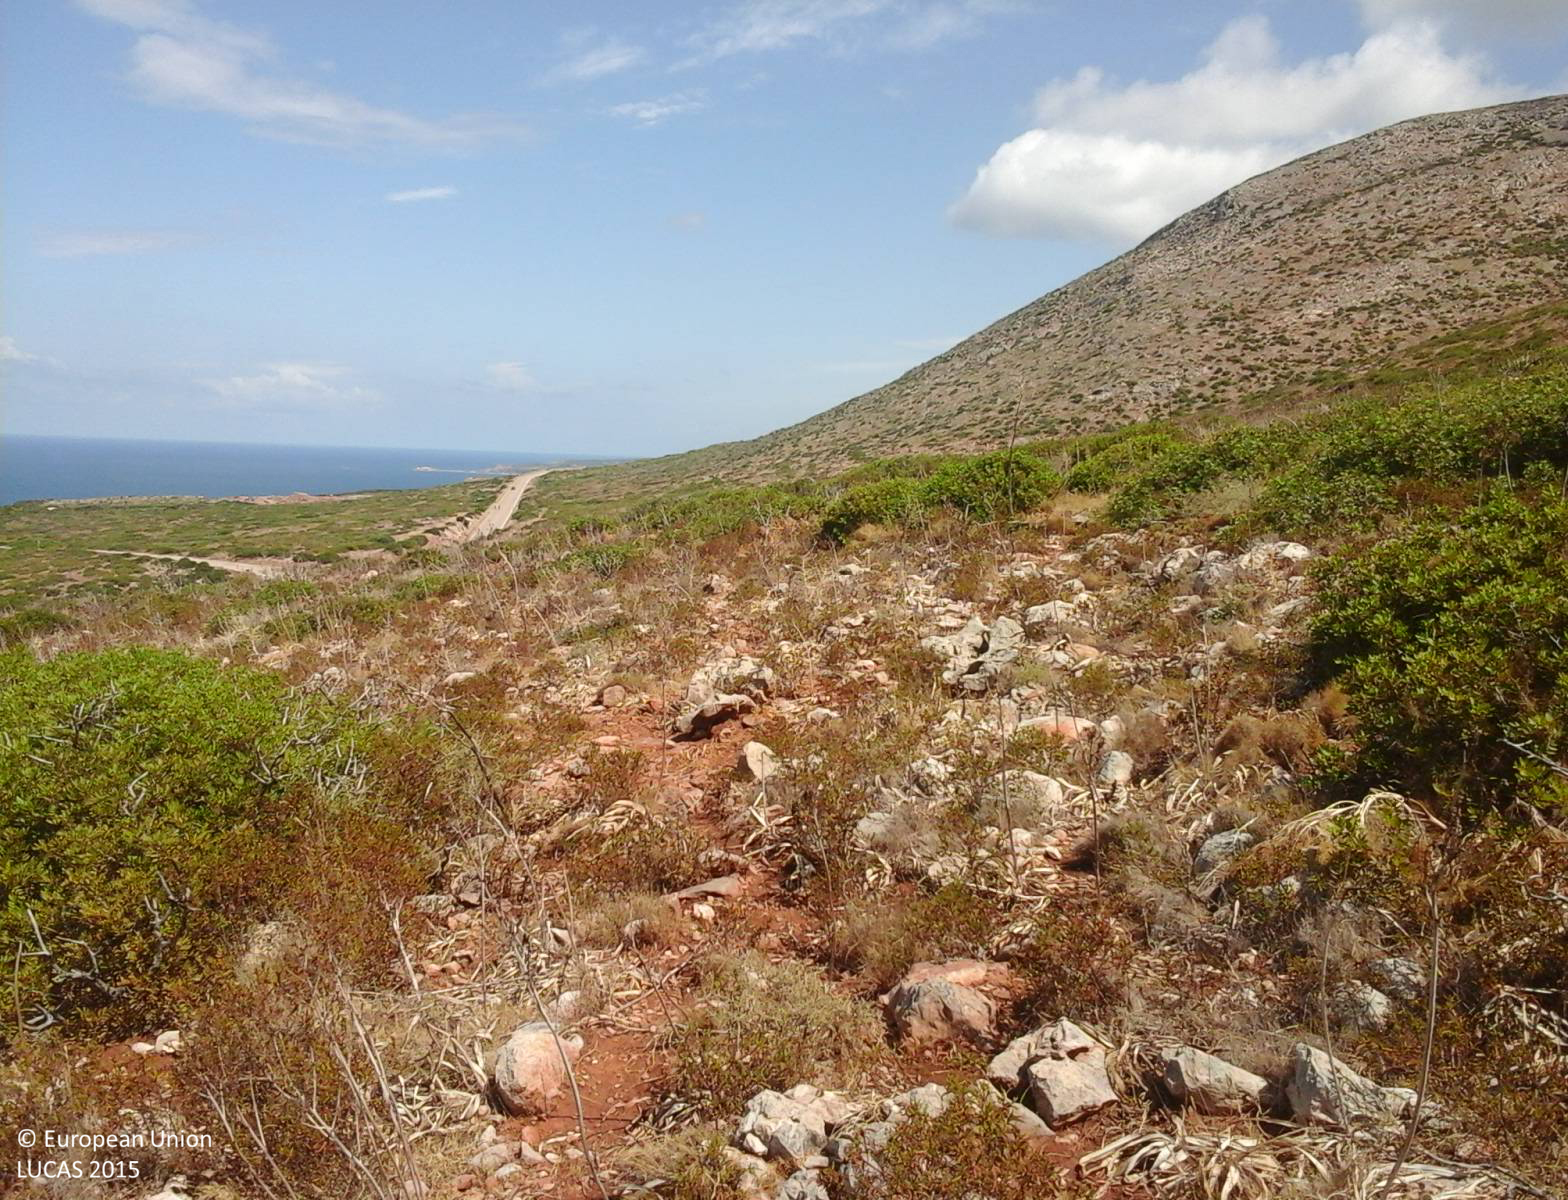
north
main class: Shrubland
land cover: Shrubland without tree cover
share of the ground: > 75 %
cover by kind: shrubs 100 %
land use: Forestry
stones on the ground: > 50 %
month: August
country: IT
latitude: 39.3848
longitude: 8.3959
